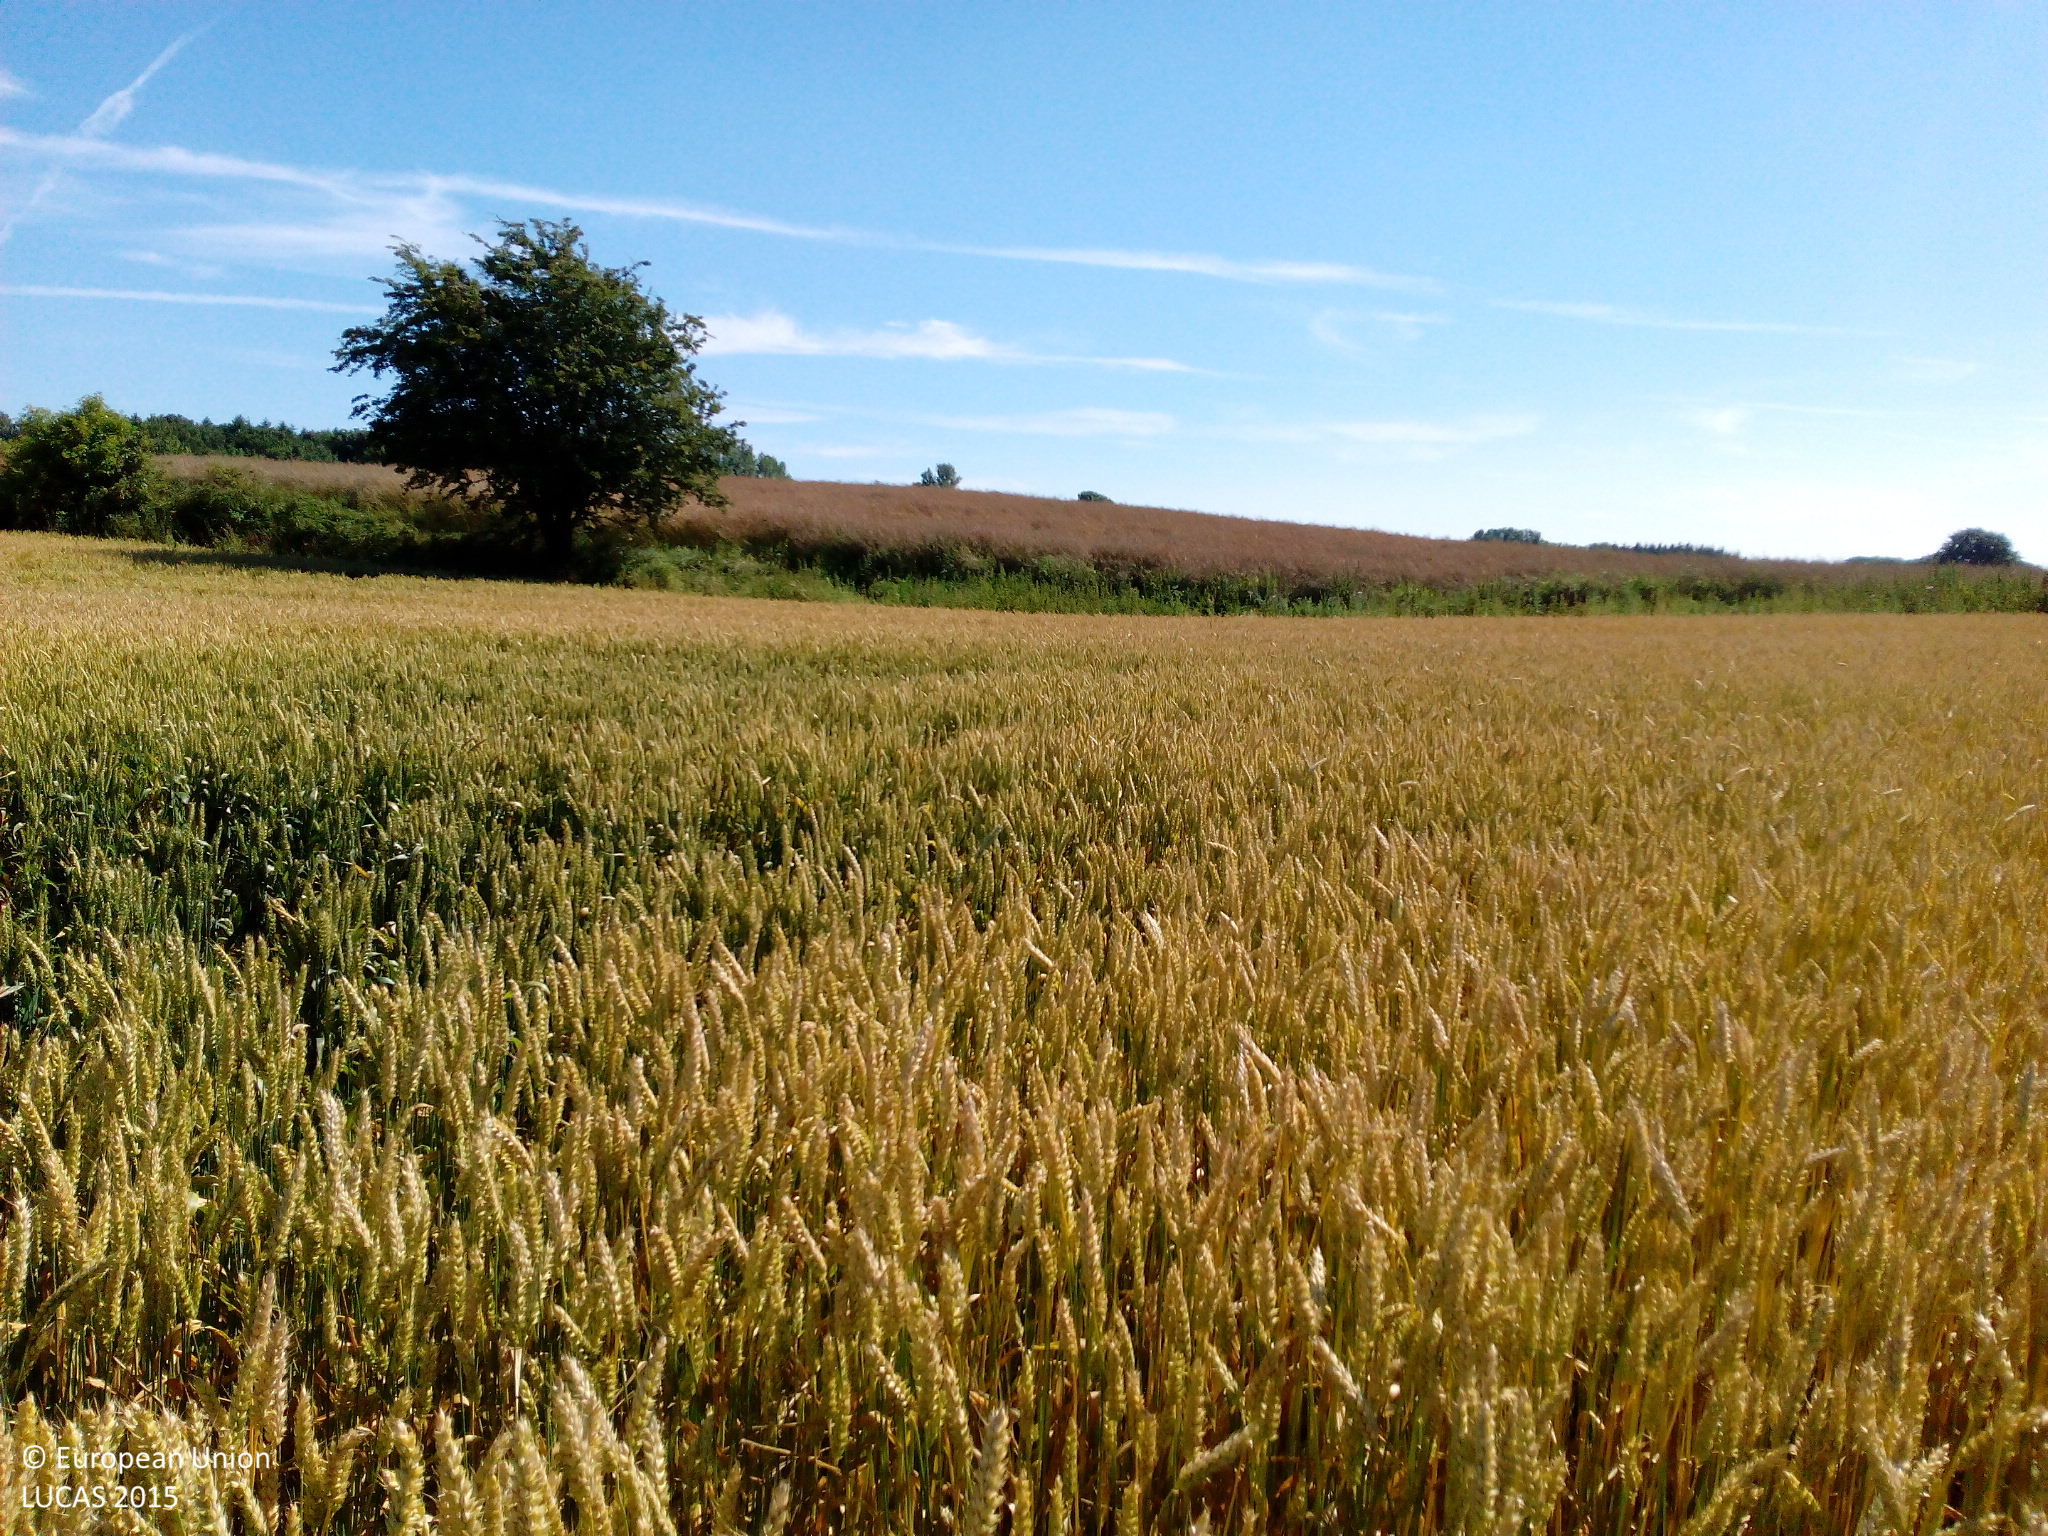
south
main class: Cropland
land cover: Common wheat
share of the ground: > 75 %
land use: Agriculture (excluding fallow land and kitchen gardens)
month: August
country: DK
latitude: 55.6008
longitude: 11.7284
